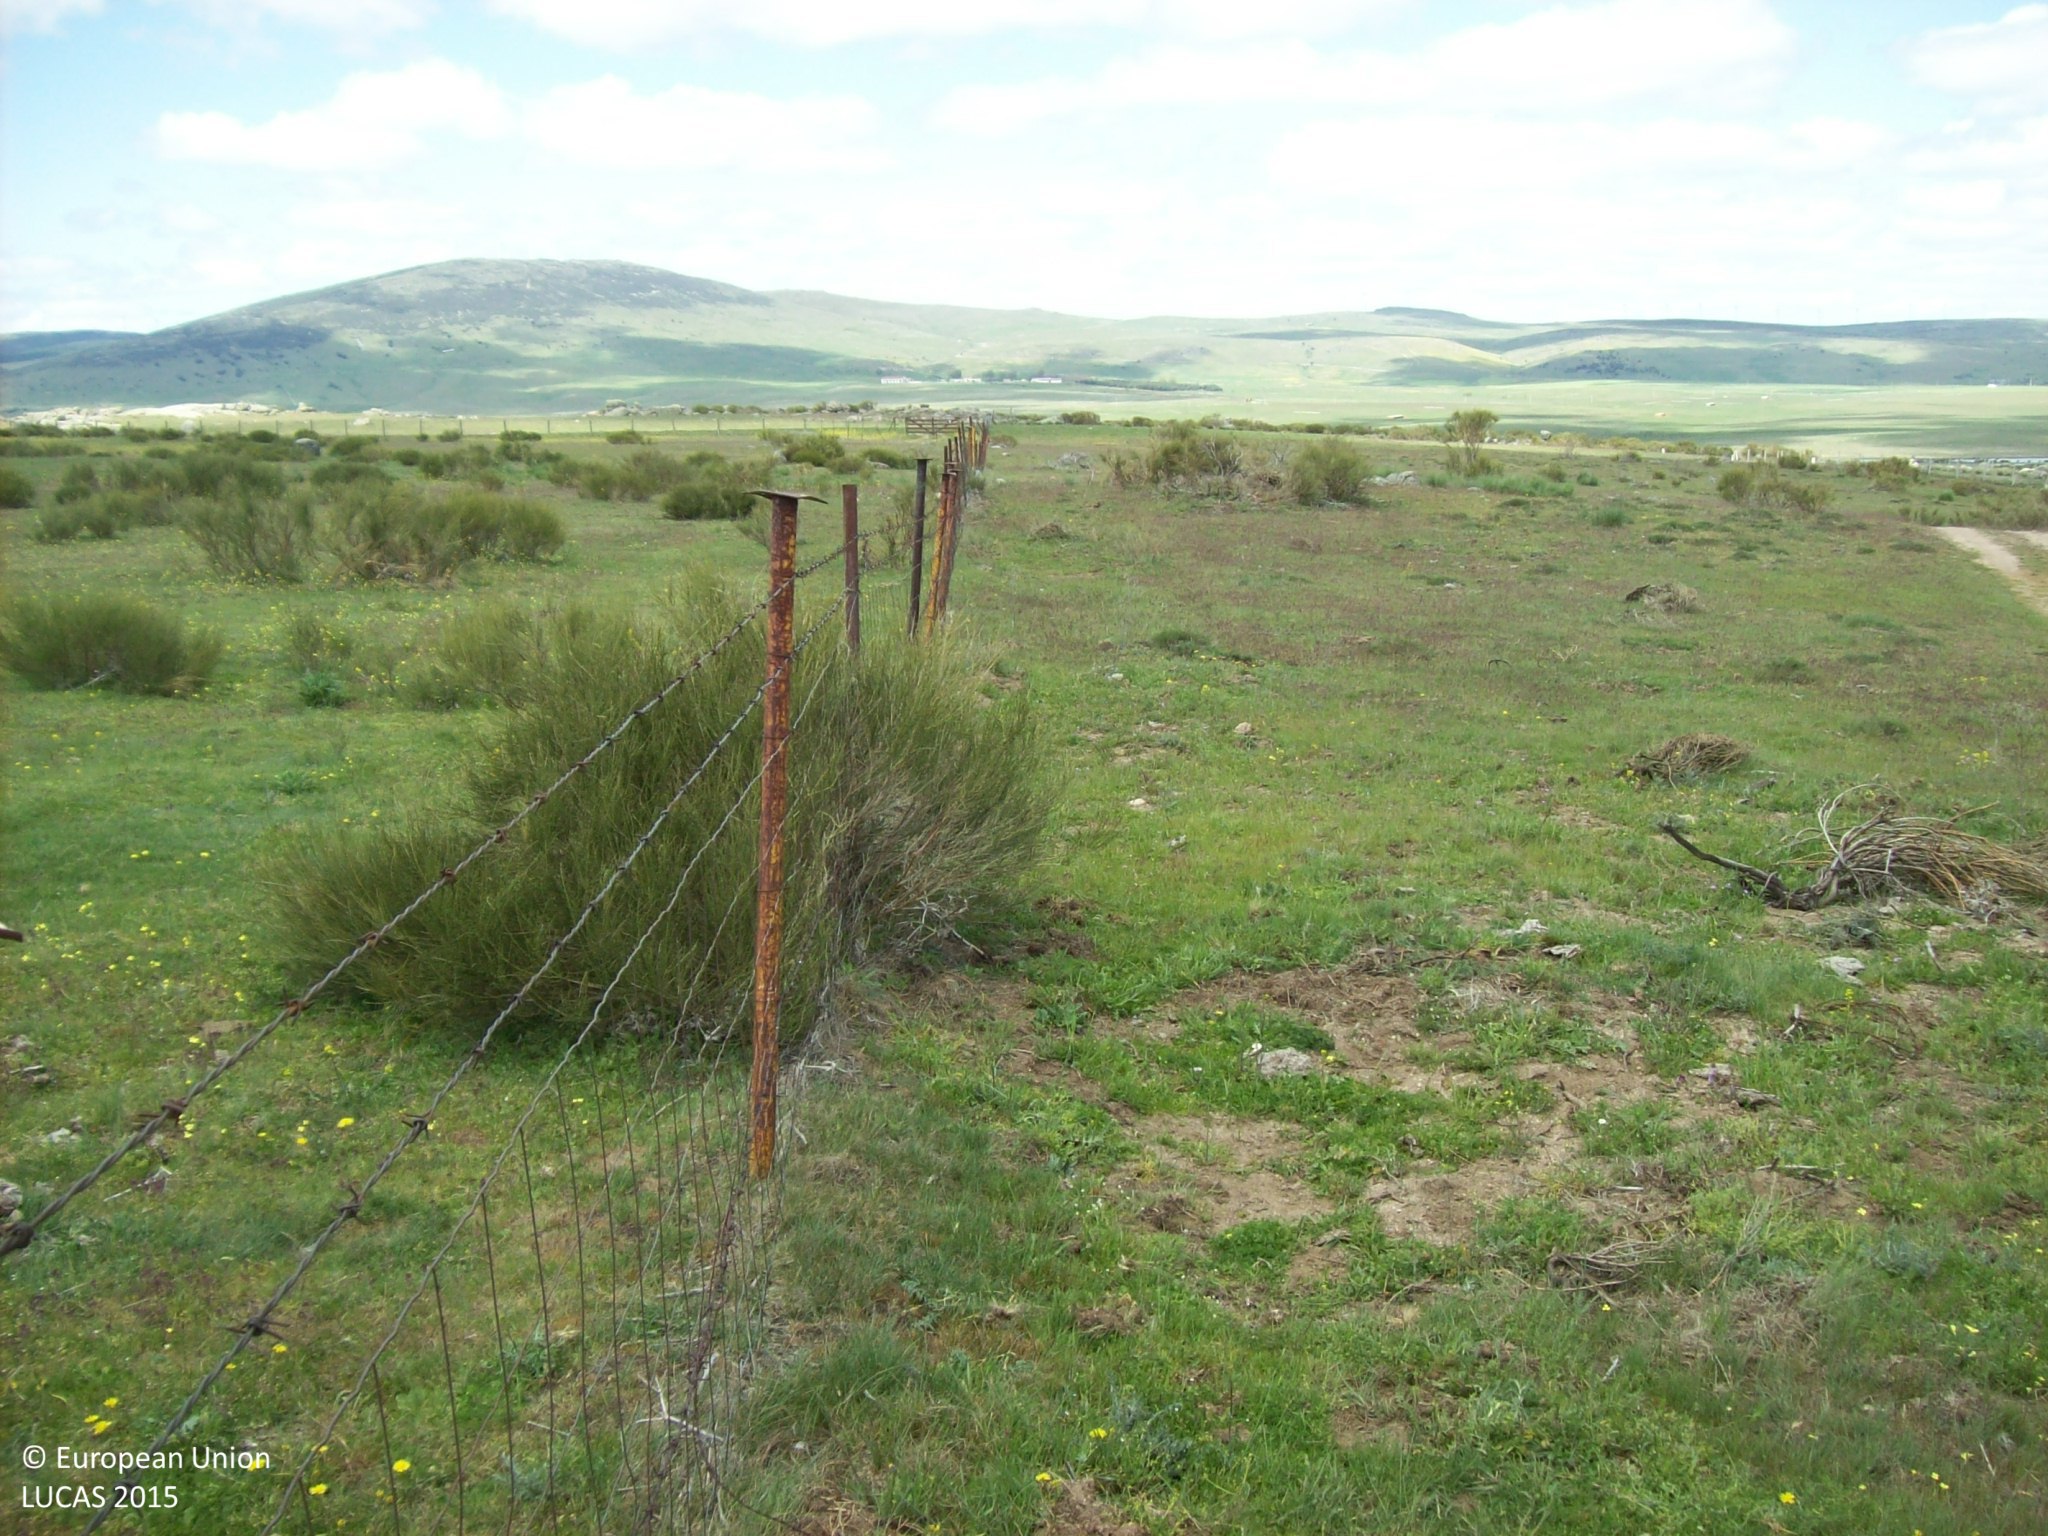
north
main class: Grassland
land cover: Grassland without tree/shrub cover
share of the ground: > 75 %
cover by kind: herbaceous plants 95 %, shrubs 5 %
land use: Agriculture (excluding fallow land and kitchen gardens)
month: May
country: ES
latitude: 40.6593
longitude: -4.4459
